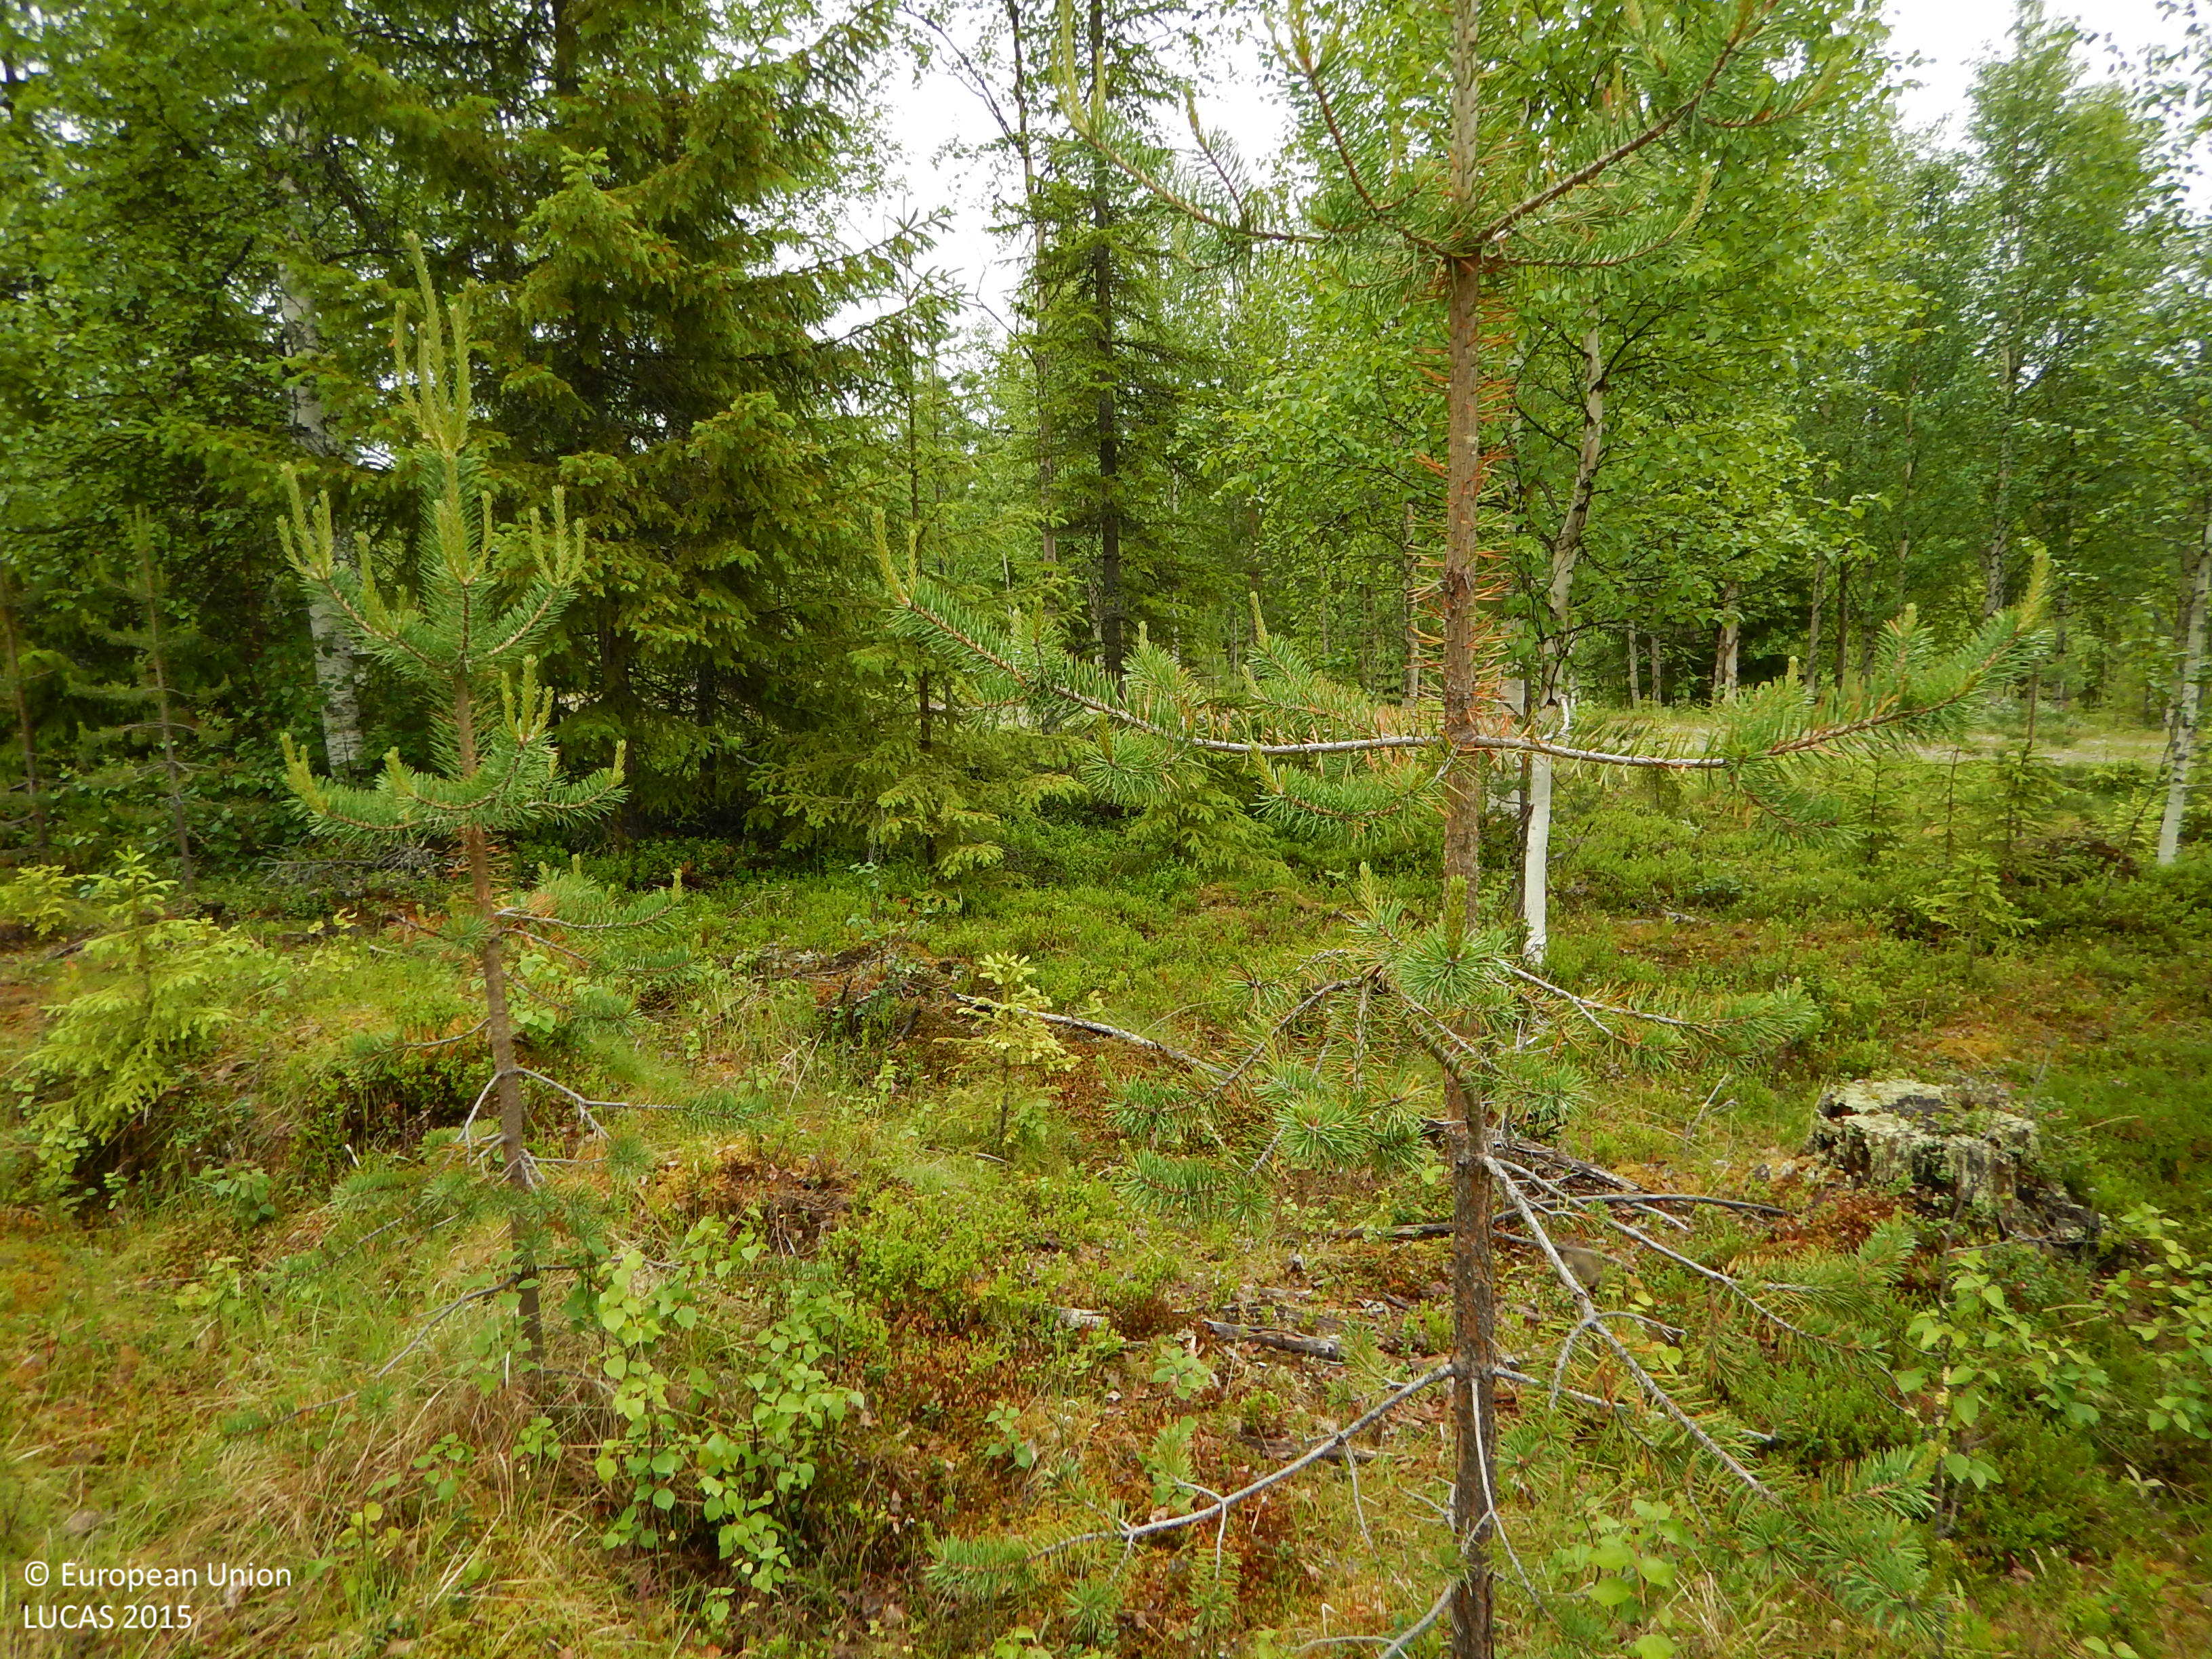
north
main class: Woodland
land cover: Pine dominated mixed woodland
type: boreal forest
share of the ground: 25 - 50 %
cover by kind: herbaceous plants 40 %, lichens and mosses 25 %, coniferous forest trees 20 %, broadleaved forest trees 10 %, shrubs 5 %
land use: Forestry
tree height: < 5 m
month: July
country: SE
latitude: 65.1626
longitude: 18.6471
